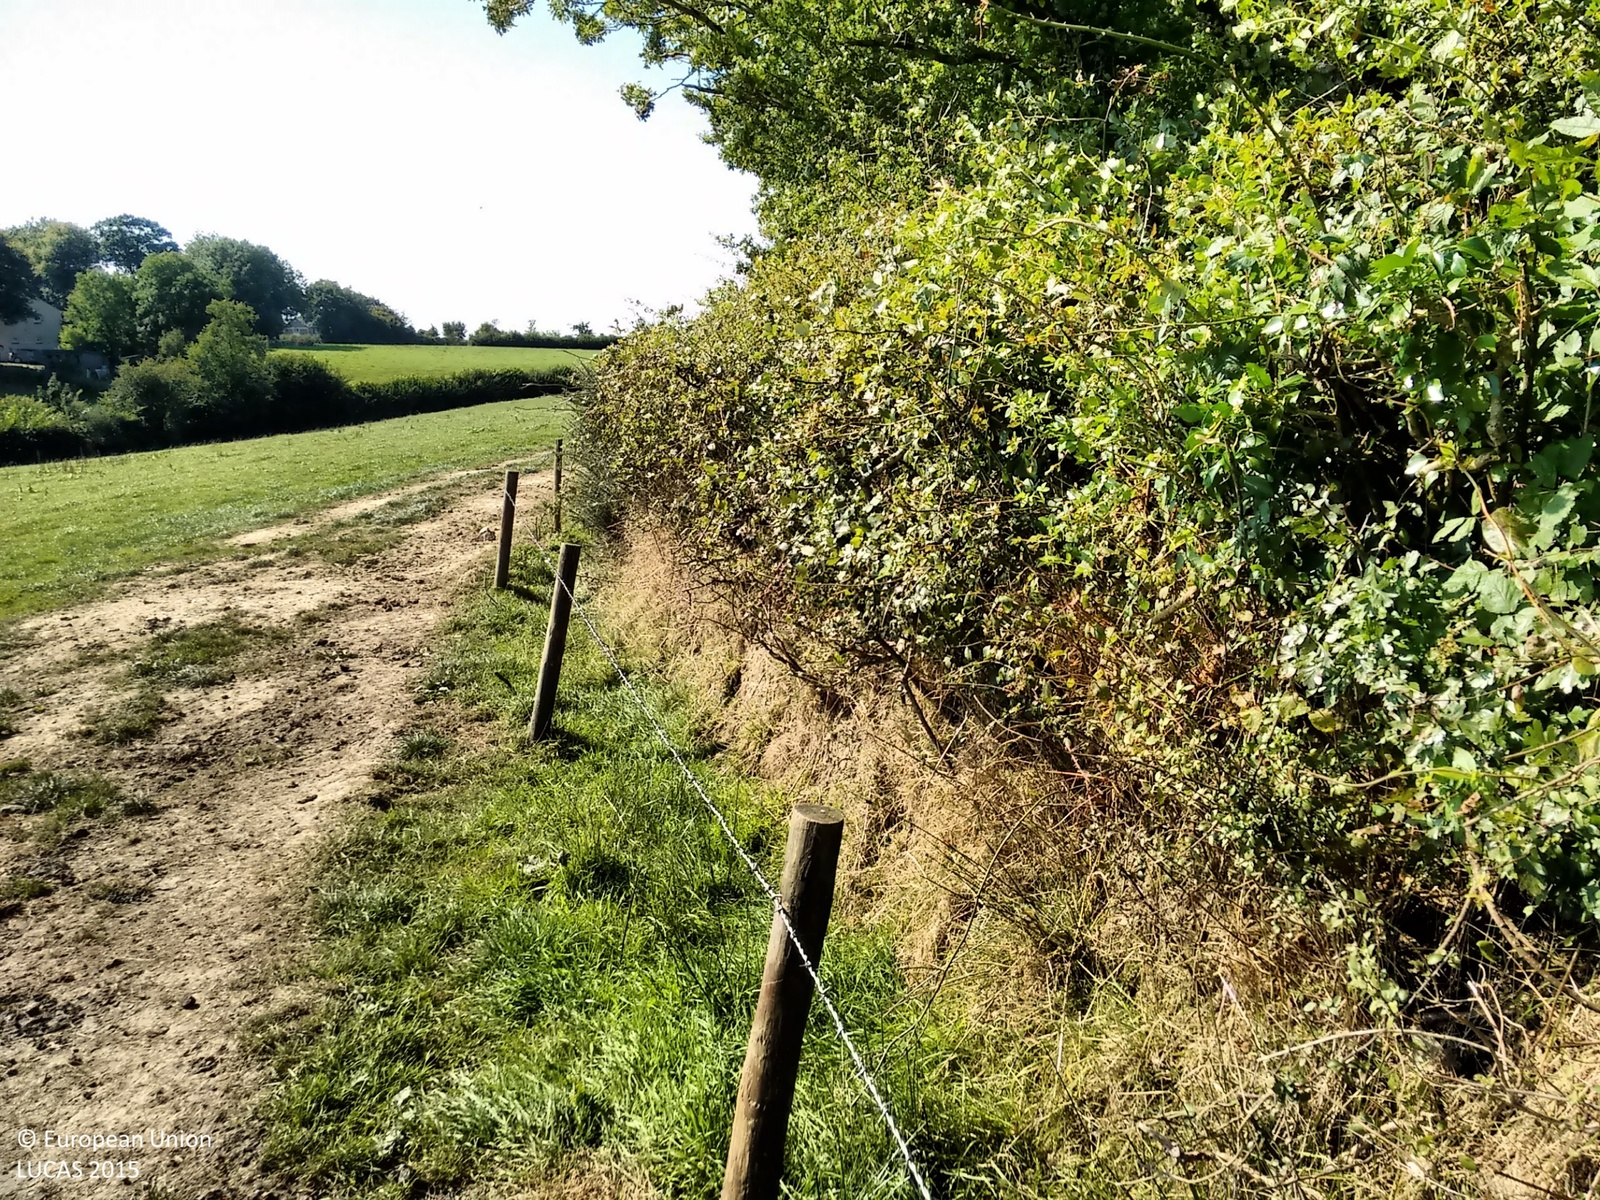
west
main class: Woodland
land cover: Broadleaved woodland
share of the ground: > 75 %
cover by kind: broadleaved forest trees 100 %
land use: Agriculture (excluding fallow land and kitchen gardens)
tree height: > 5 m
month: September
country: GB
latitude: 50.8593
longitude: -4.0605
